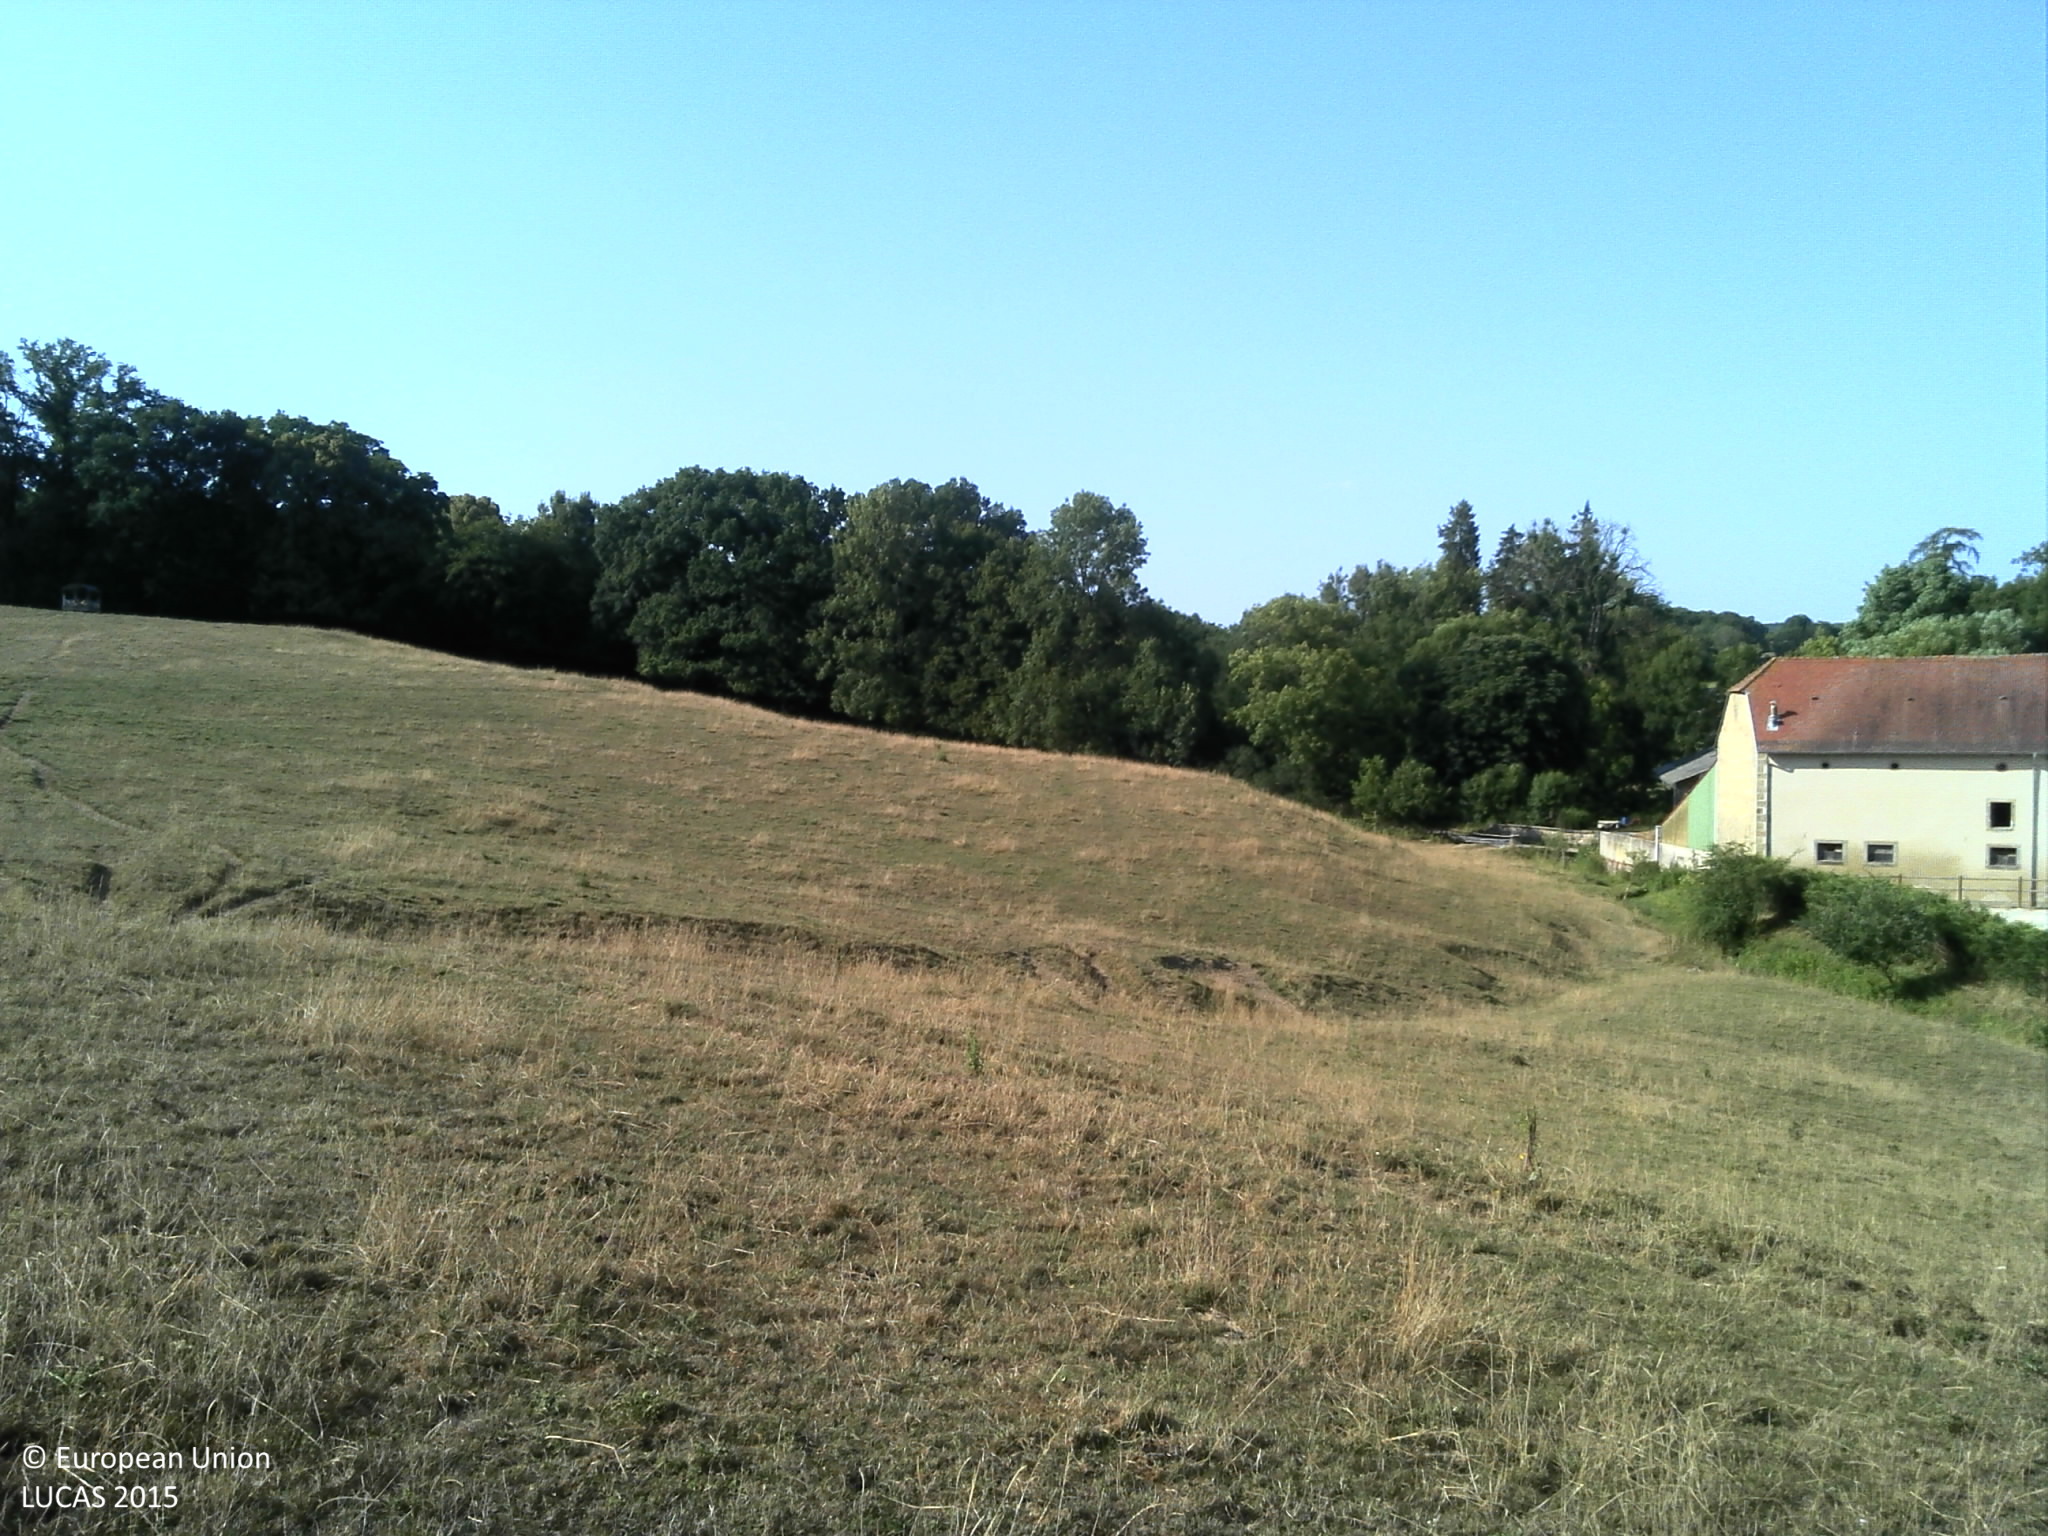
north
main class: Grassland
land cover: Grassland without tree/shrub cover
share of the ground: > 75 %
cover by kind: herbaceous plants 100 %
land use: Agriculture (excluding fallow land and kitchen gardens)
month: July
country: FR
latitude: 49.1129
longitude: 6.7808
